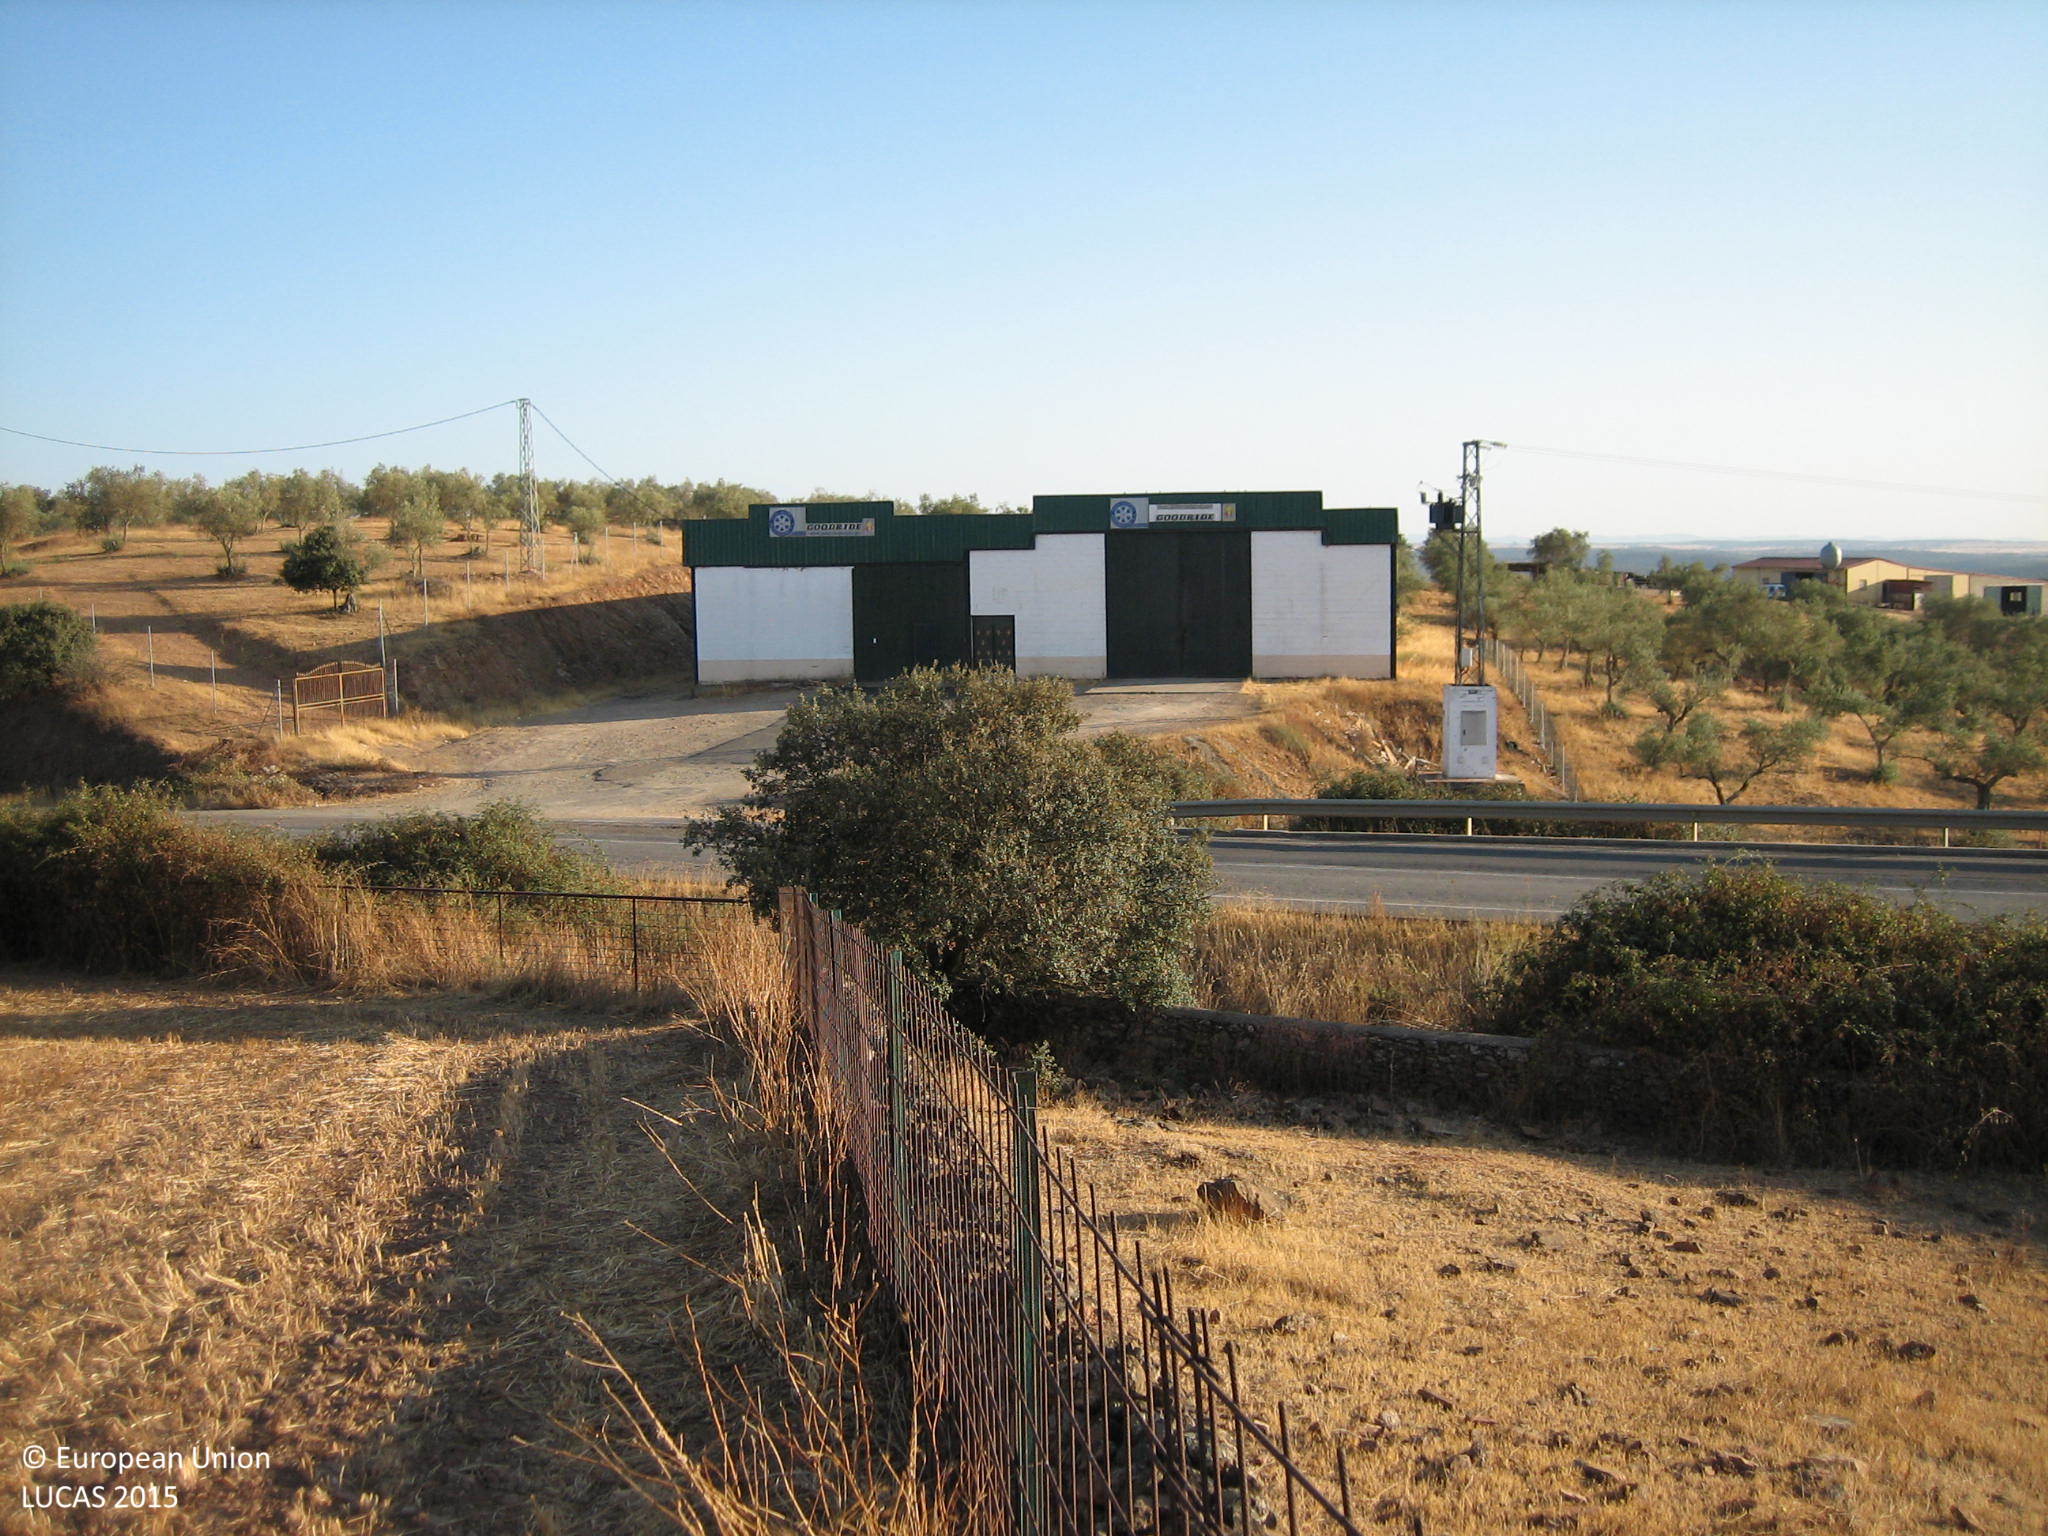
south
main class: Grassland
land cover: Grassland without tree/shrub cover
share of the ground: 50 - 75 %
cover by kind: herbaceous plants 70 %, unconsolidated bare surface 30 %
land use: Agriculture (excluding fallow land and kitchen gardens)
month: September
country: ES
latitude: 38.3746
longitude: -7.1540
